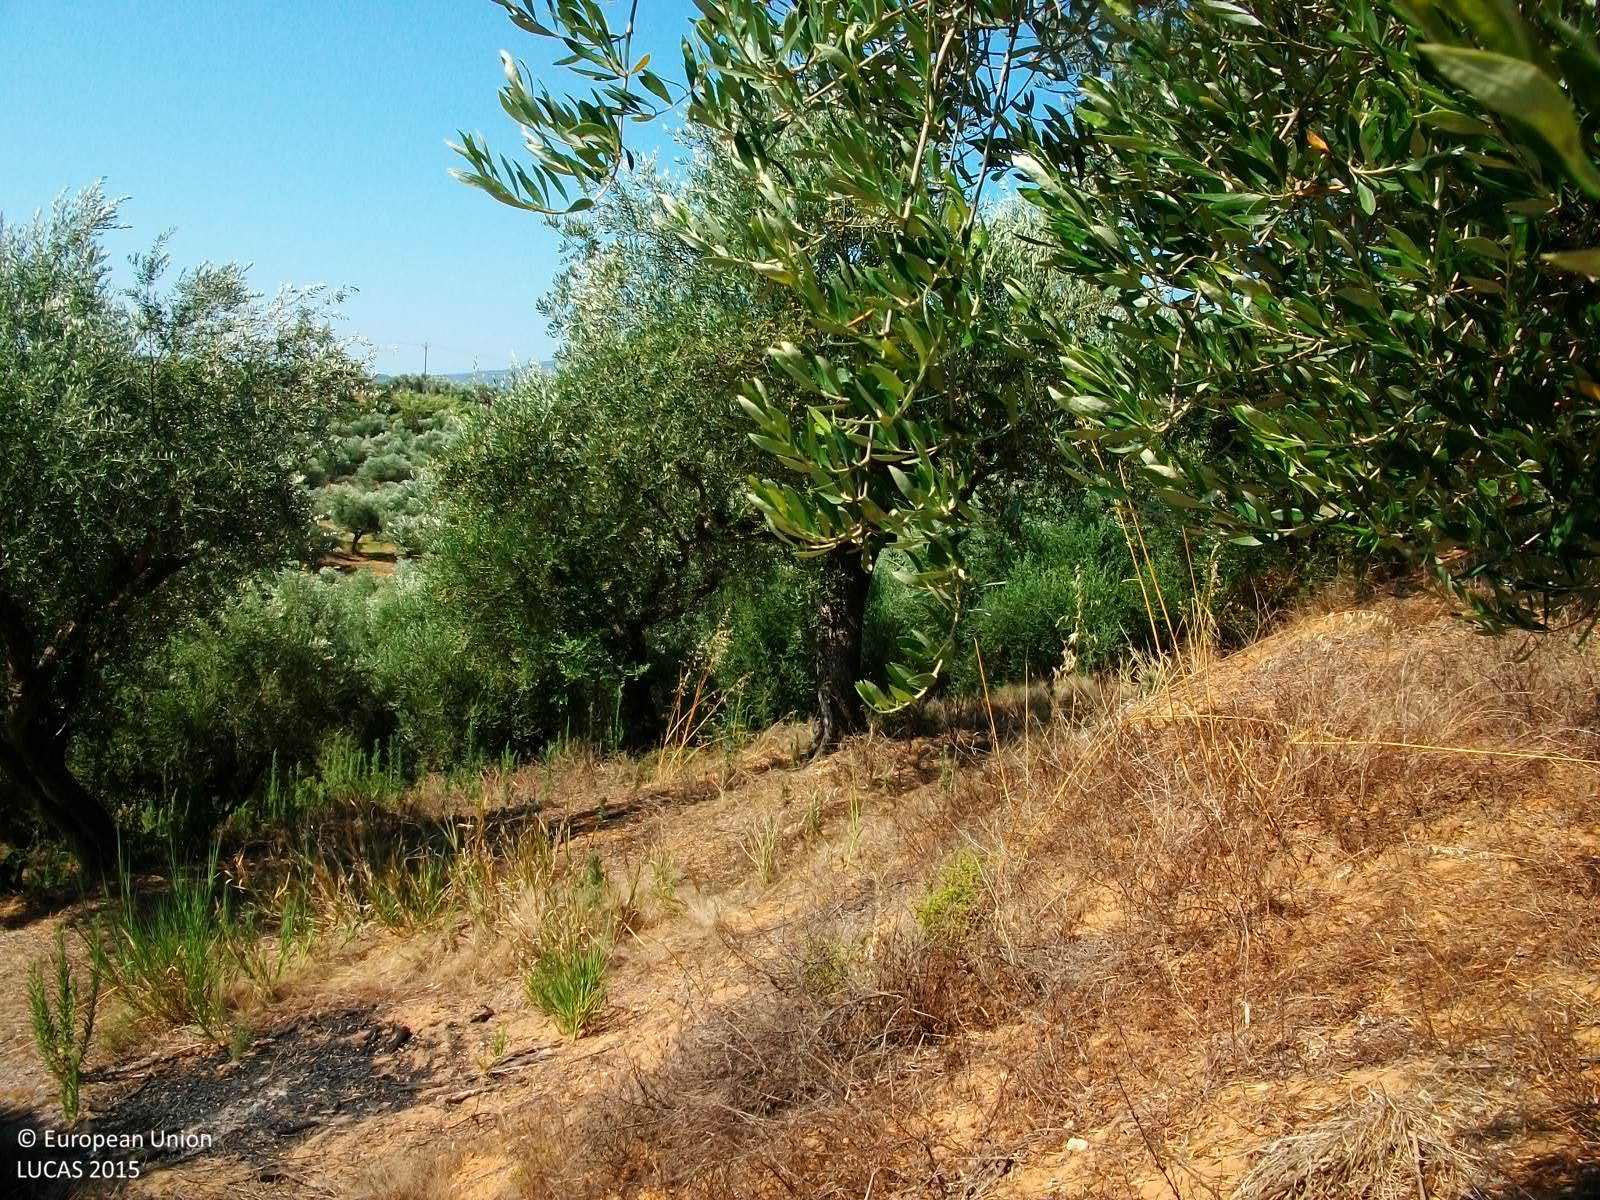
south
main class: Cropland
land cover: Olive groves
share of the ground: 25 - 50 %
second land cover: Spontaneously vegetated surfaces
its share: > 75 %
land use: Agriculture (excluding fallow land and kitchen gardens)
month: July
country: GR
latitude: 37.0102
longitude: 21.9438
